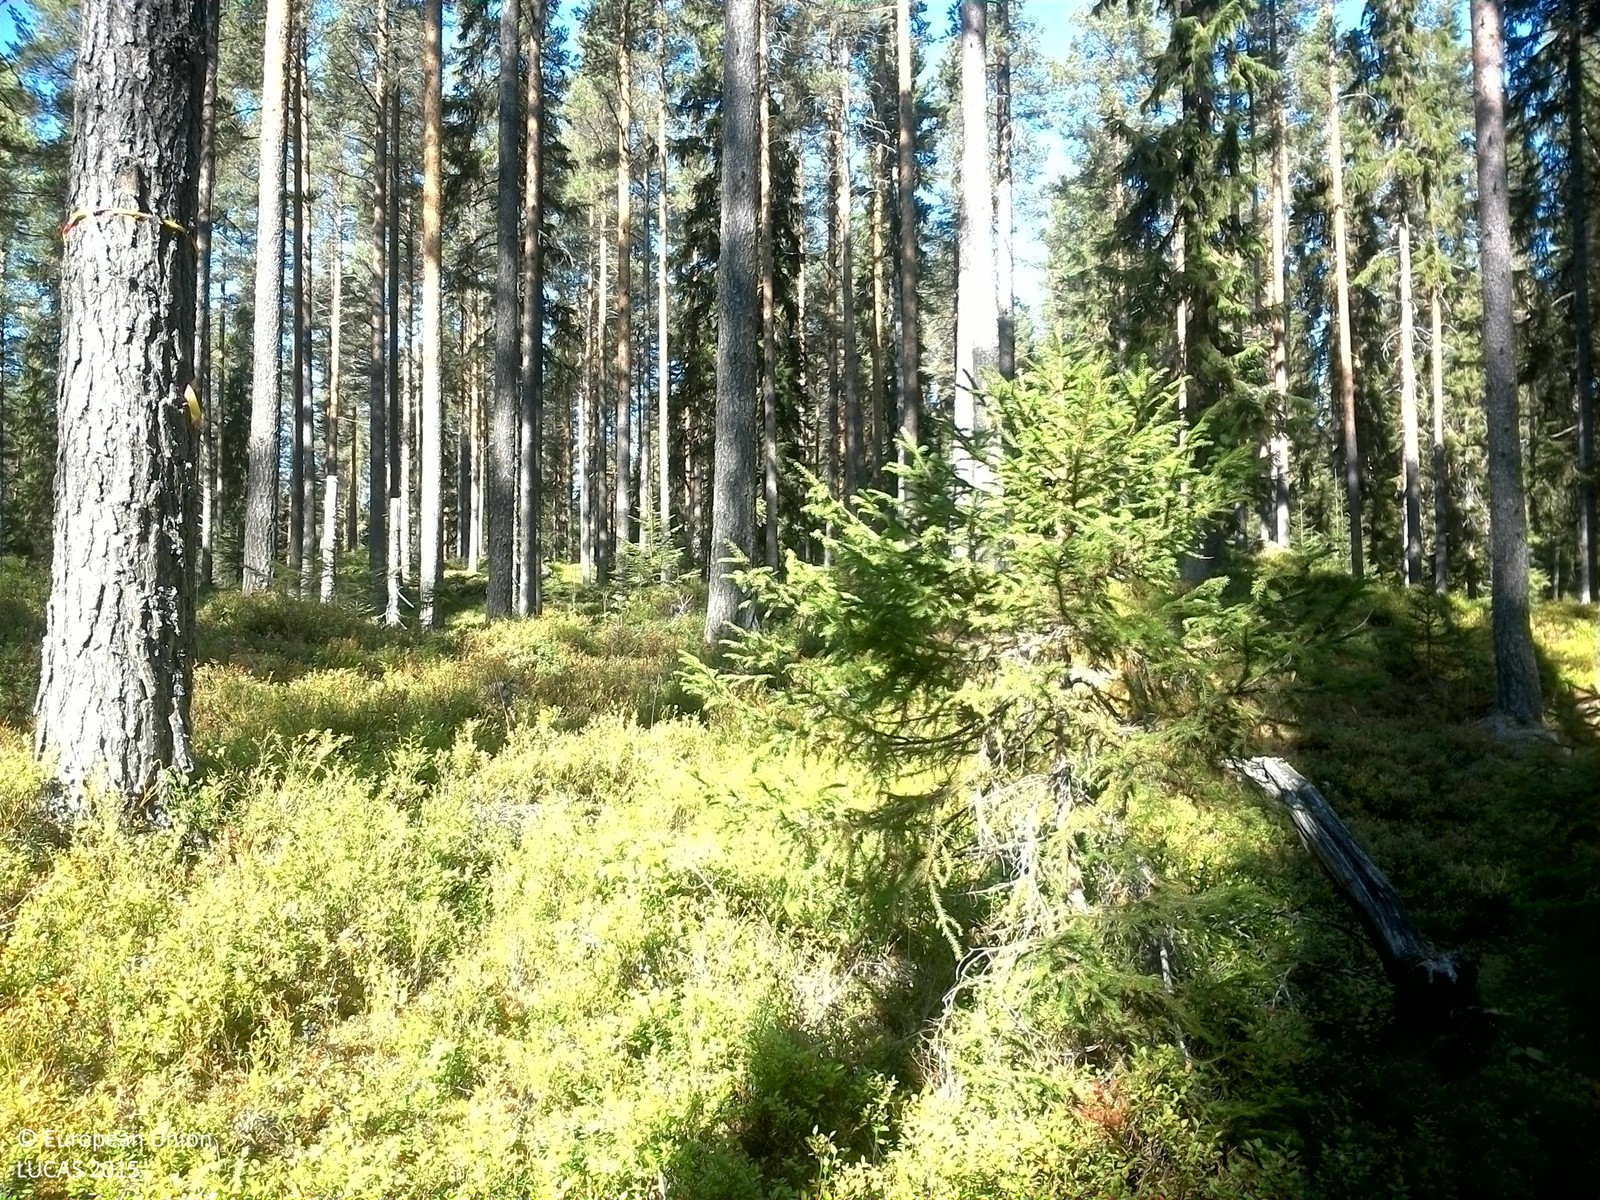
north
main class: Woodland
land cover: Pine dominated coniferous woodland
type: boreal forest
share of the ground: 50 - 75 %
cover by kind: coniferous forest trees 50 %, shrubs 35 %, lichens and mosses 15 %
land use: Forestry
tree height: > 5 m
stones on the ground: 10 - 25 %
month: September
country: SE
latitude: 61.7551
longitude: 14.9274
